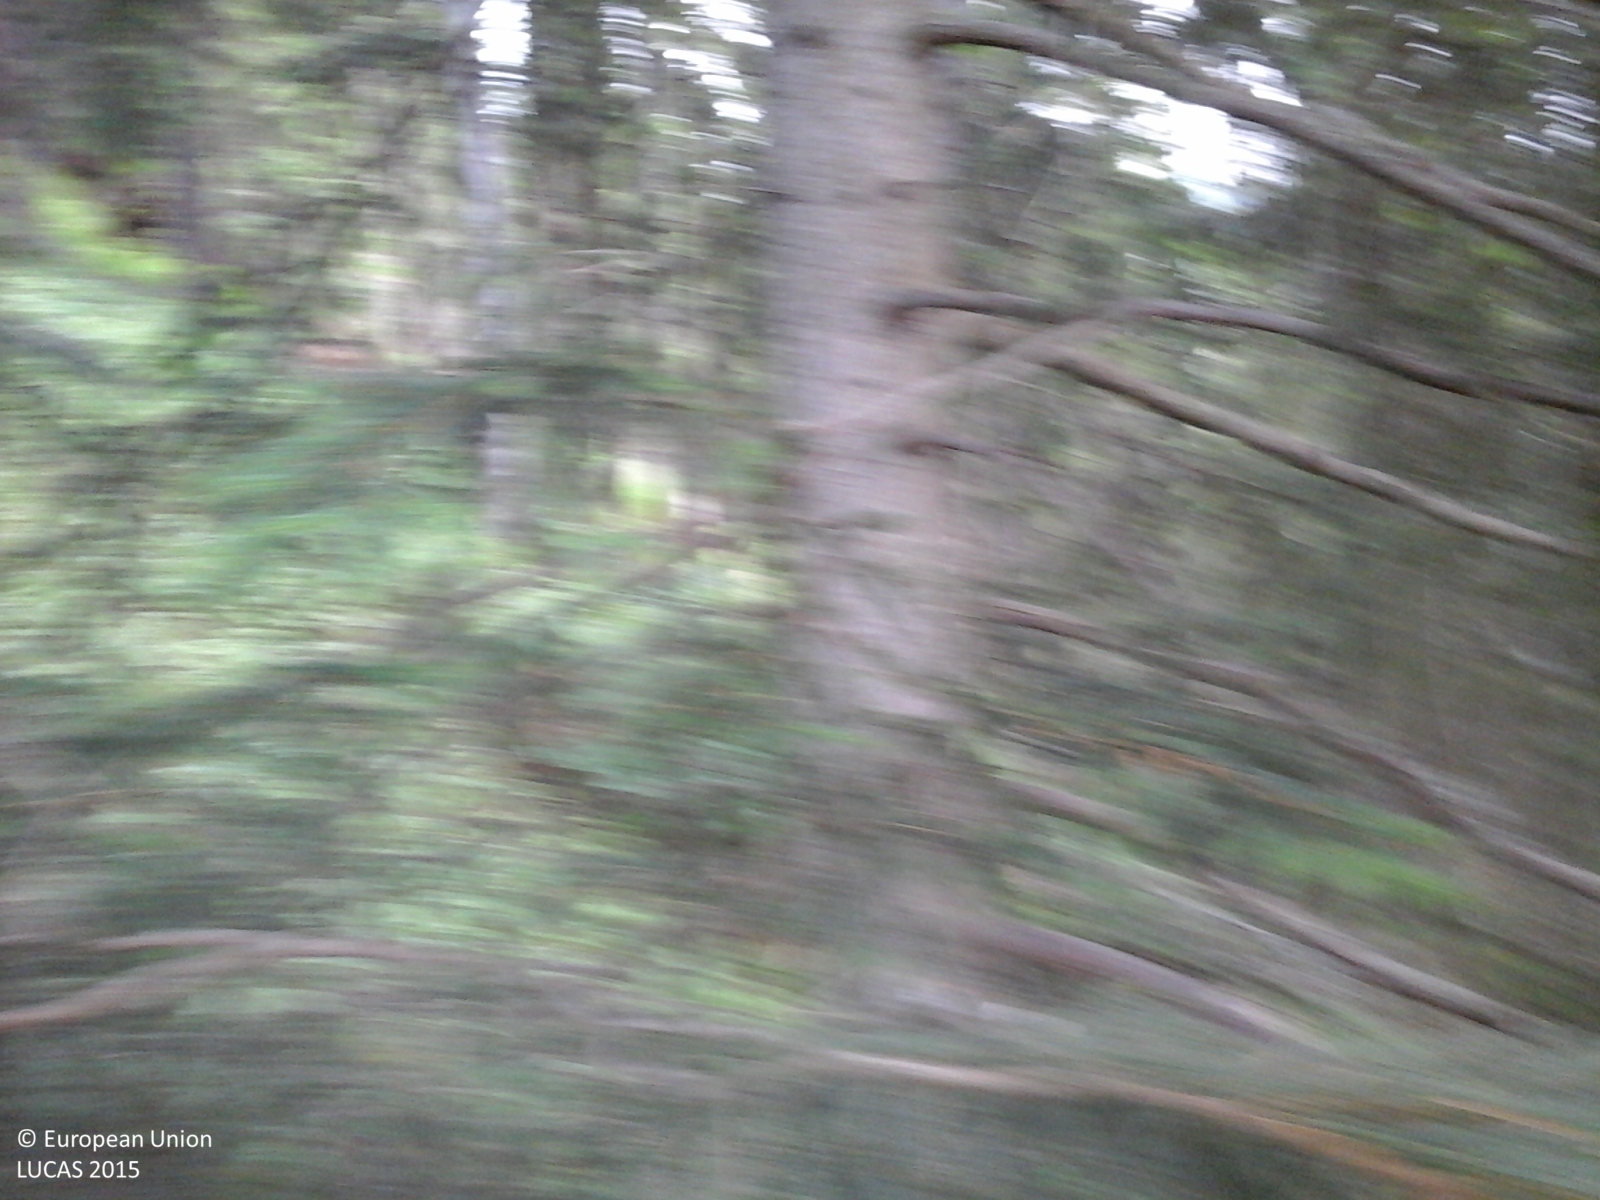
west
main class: Woodland
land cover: Spruce dominated coniferous woodland
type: alpine coniferous forest
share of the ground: > 75 %
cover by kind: coniferous forest trees 100 %
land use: Forestry
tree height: > 5 m
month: June
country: IT
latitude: 46.5529
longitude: 11.7588
